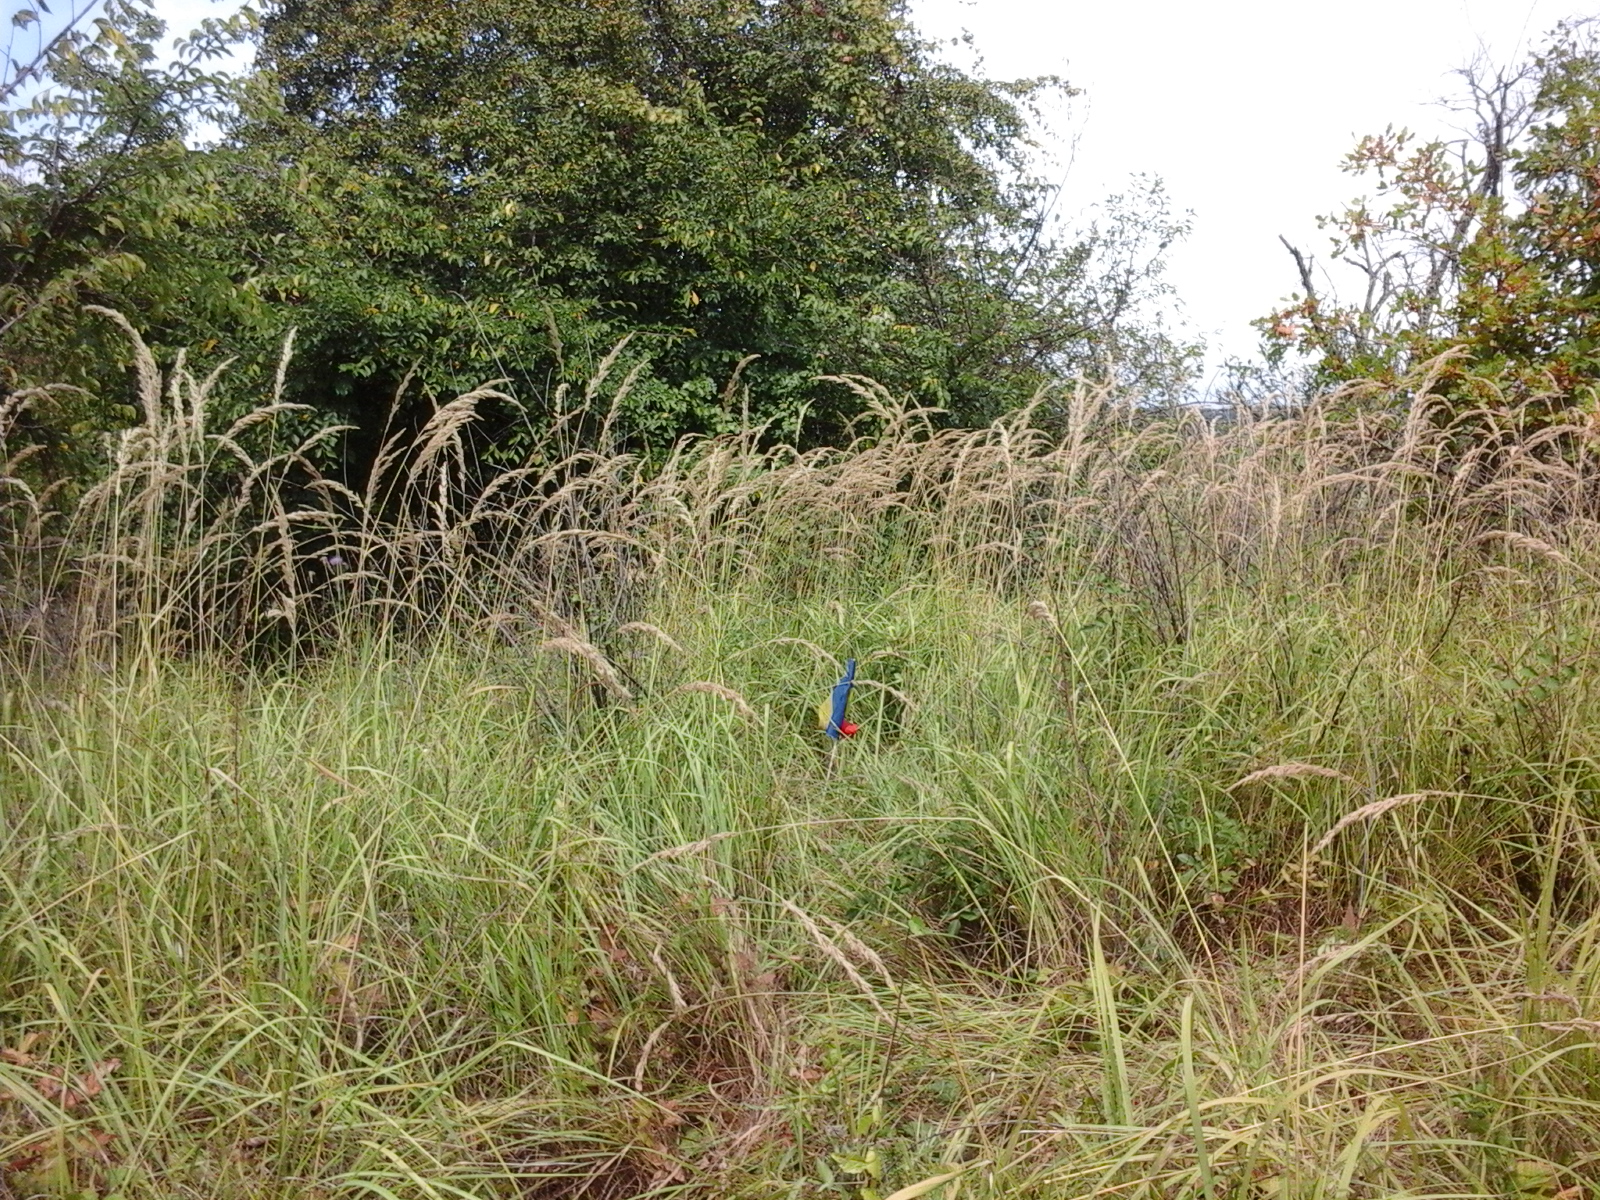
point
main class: Shrubland
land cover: Shrubland with sparse tree cover
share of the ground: > 75 %
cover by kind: shrubs 95 %, broadleaved forest trees 5 %
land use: Semi-natural and natural areas not in use
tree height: > 5 m
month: August
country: RO
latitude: 45.2312
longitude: 21.5585
